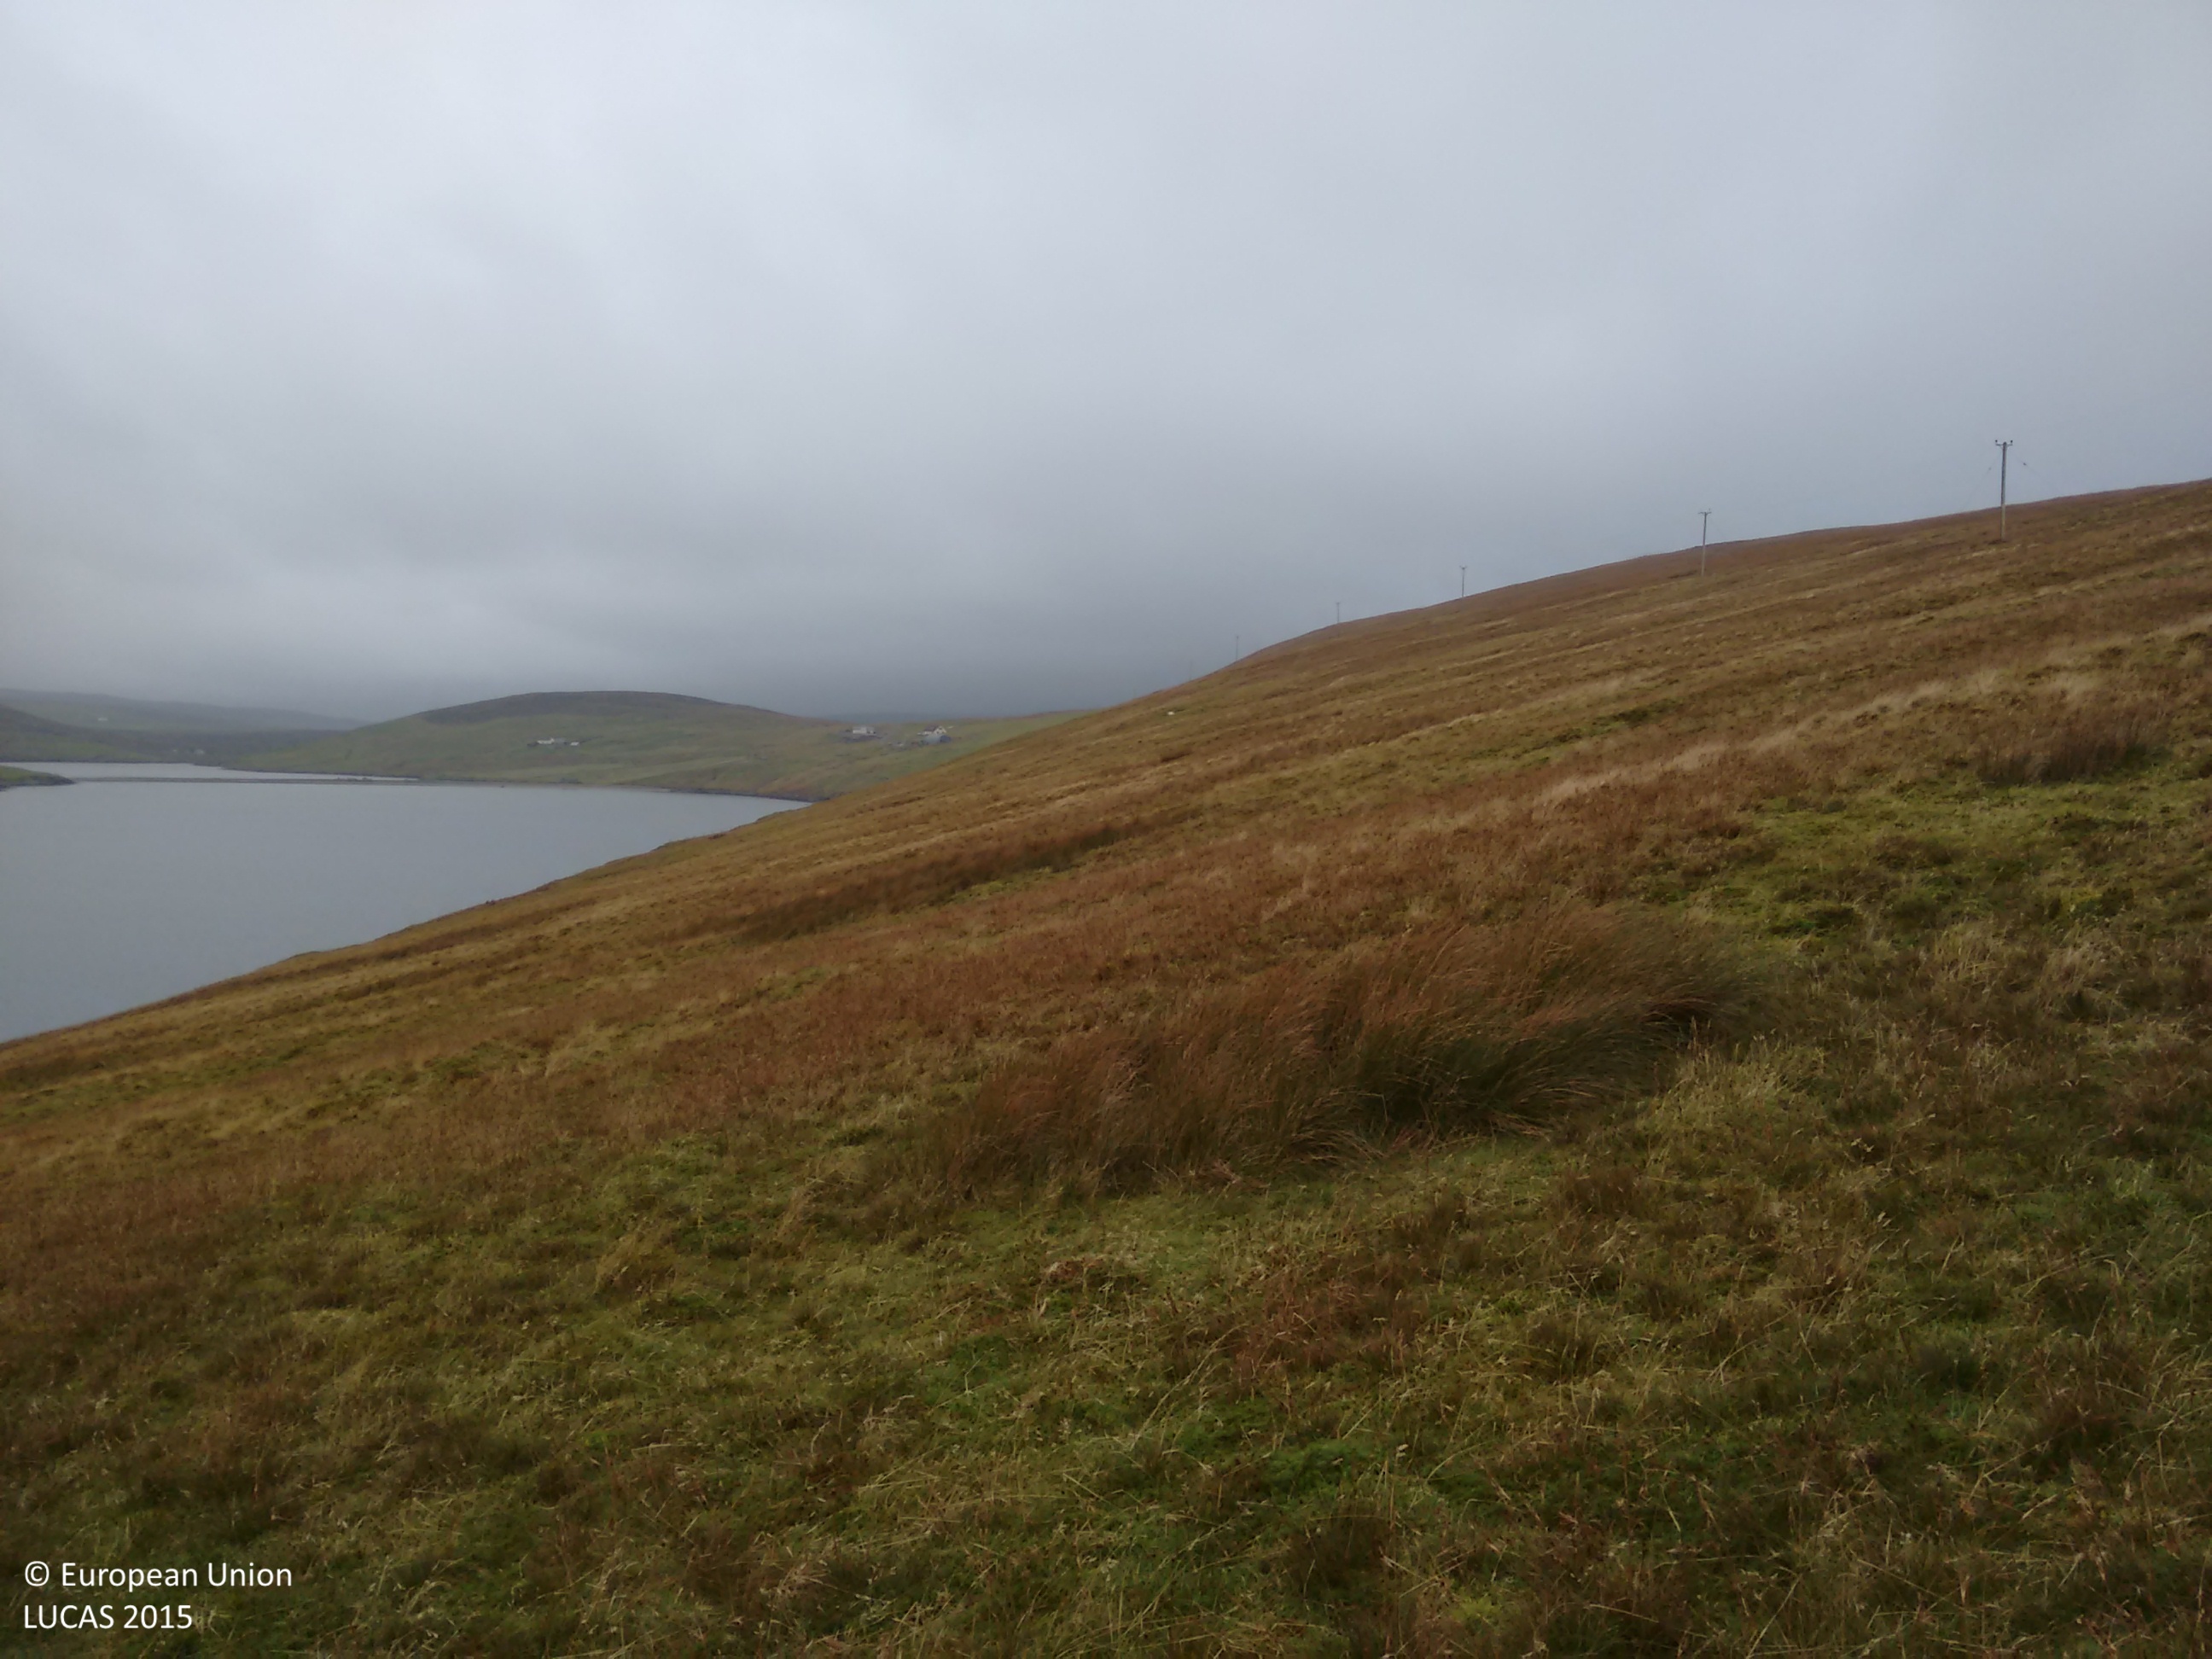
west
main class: Grassland
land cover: Grassland without tree/shrub cover
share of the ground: > 75 %
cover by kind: herbaceous plants 70 %, lichens and mosses 30 %
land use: Agriculture (excluding fallow land and kitchen gardens)
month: November
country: GB
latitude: 60.5239
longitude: -1.3321
